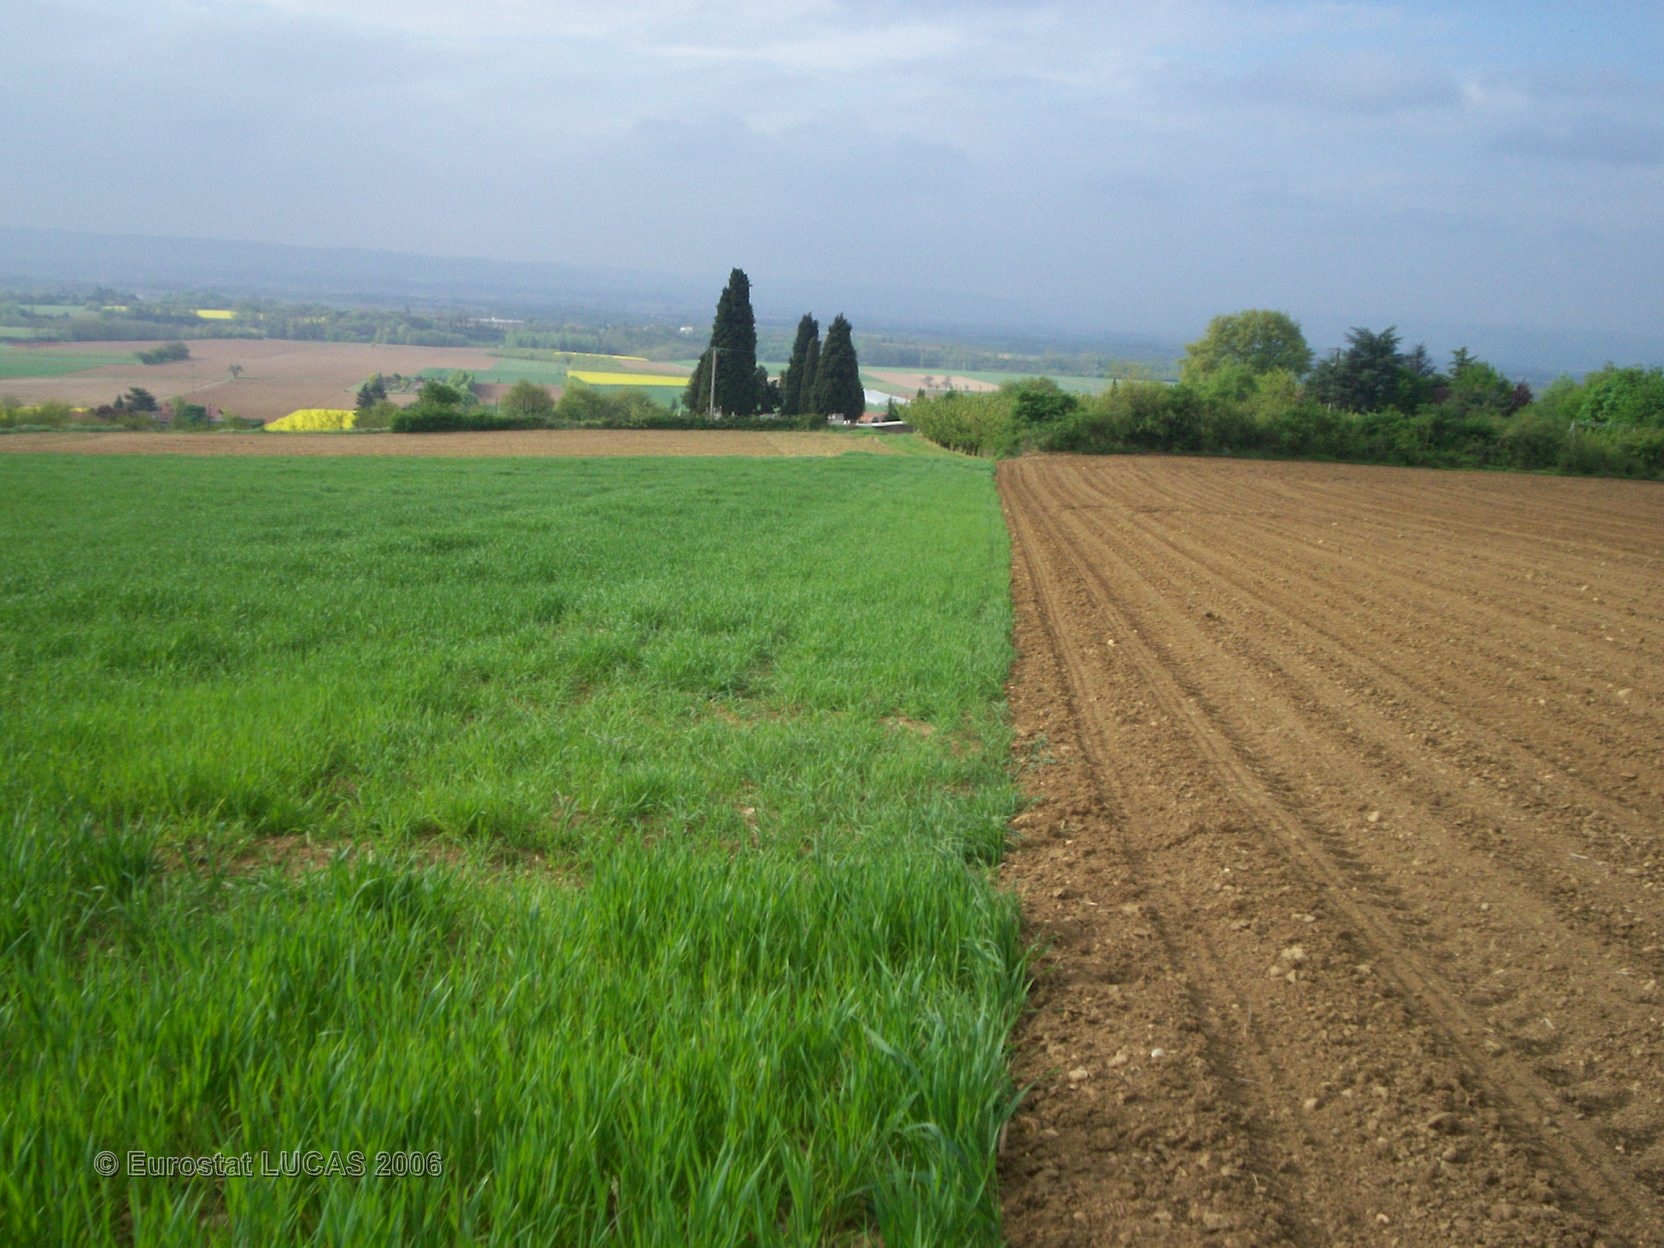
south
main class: Cropland
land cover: Common wheat
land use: Agriculture (excluding fallow land and kitchen gardens)
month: April
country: FR
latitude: 45.3432
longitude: 4.8614
